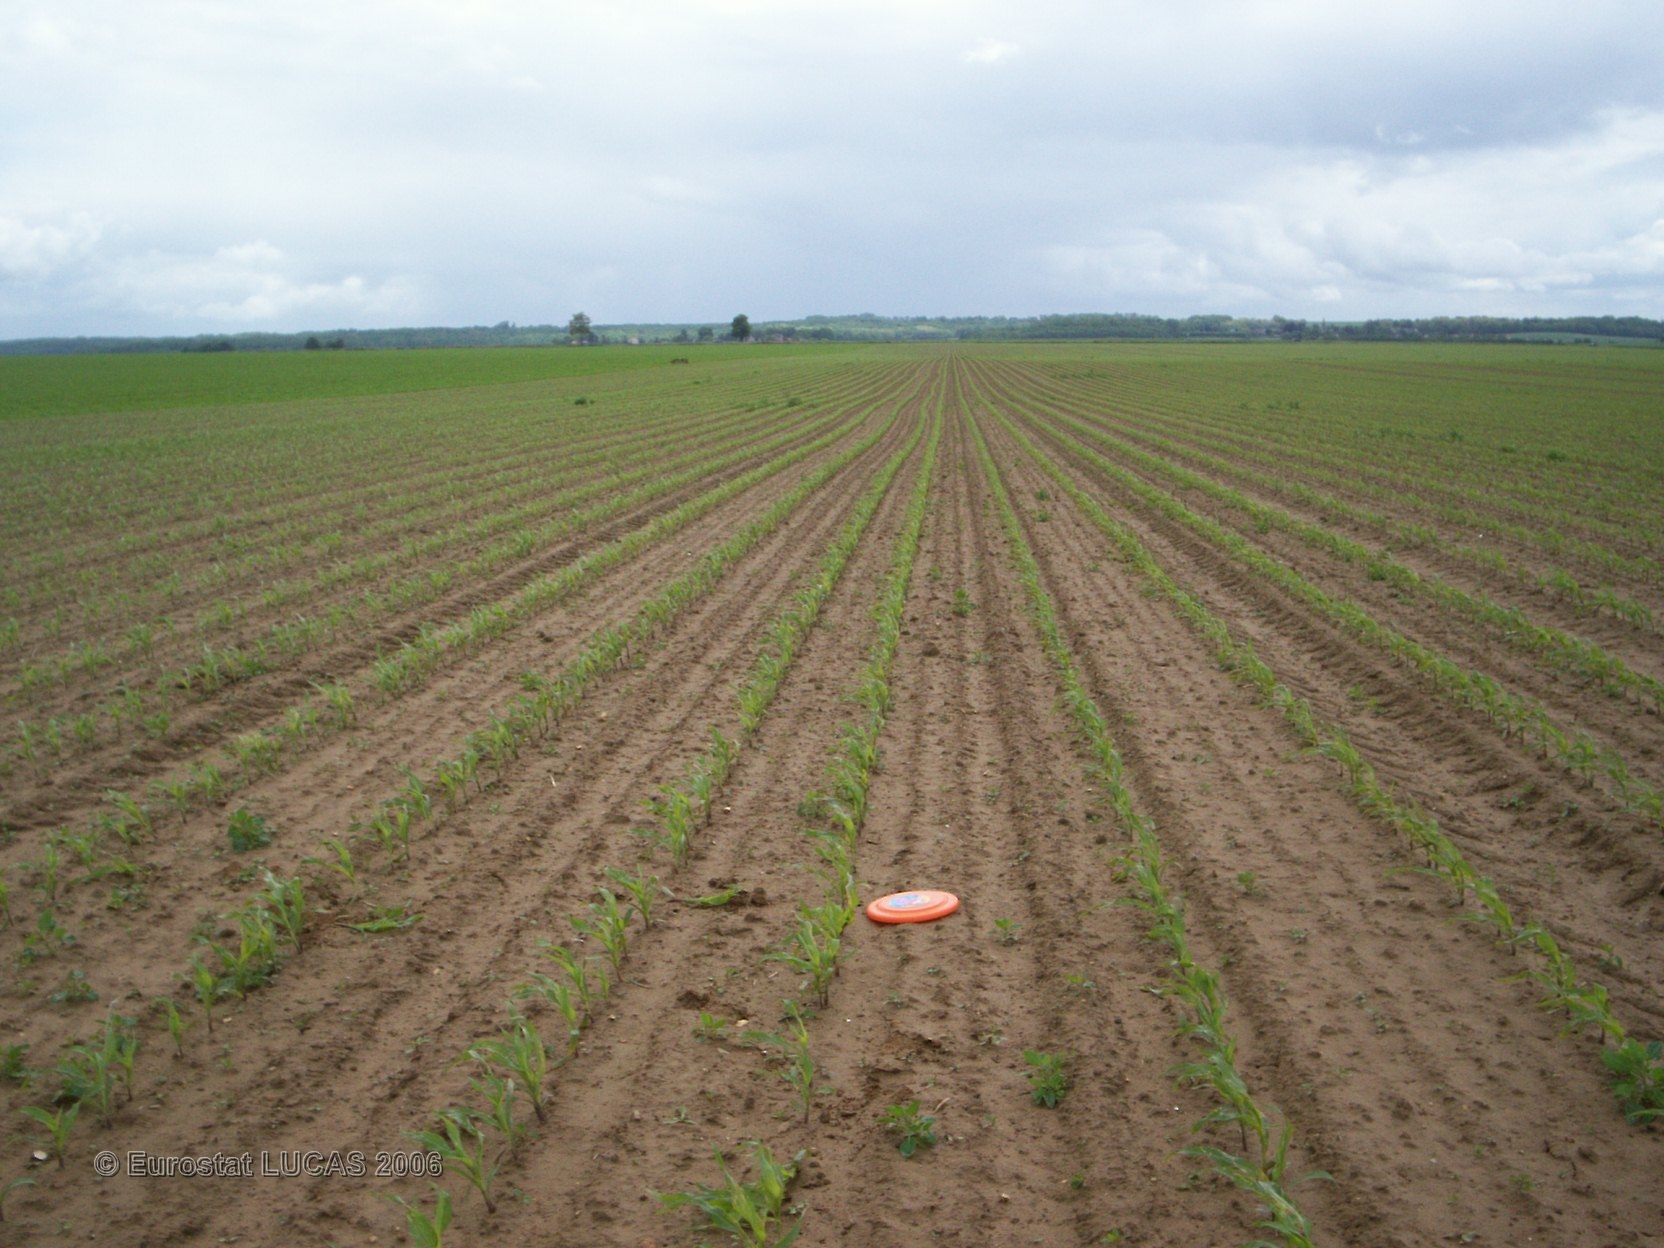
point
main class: Cropland
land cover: Maize
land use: Agriculture (excluding fallow land and kitchen gardens)
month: May
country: FR
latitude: 49.2330
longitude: 2.7798
